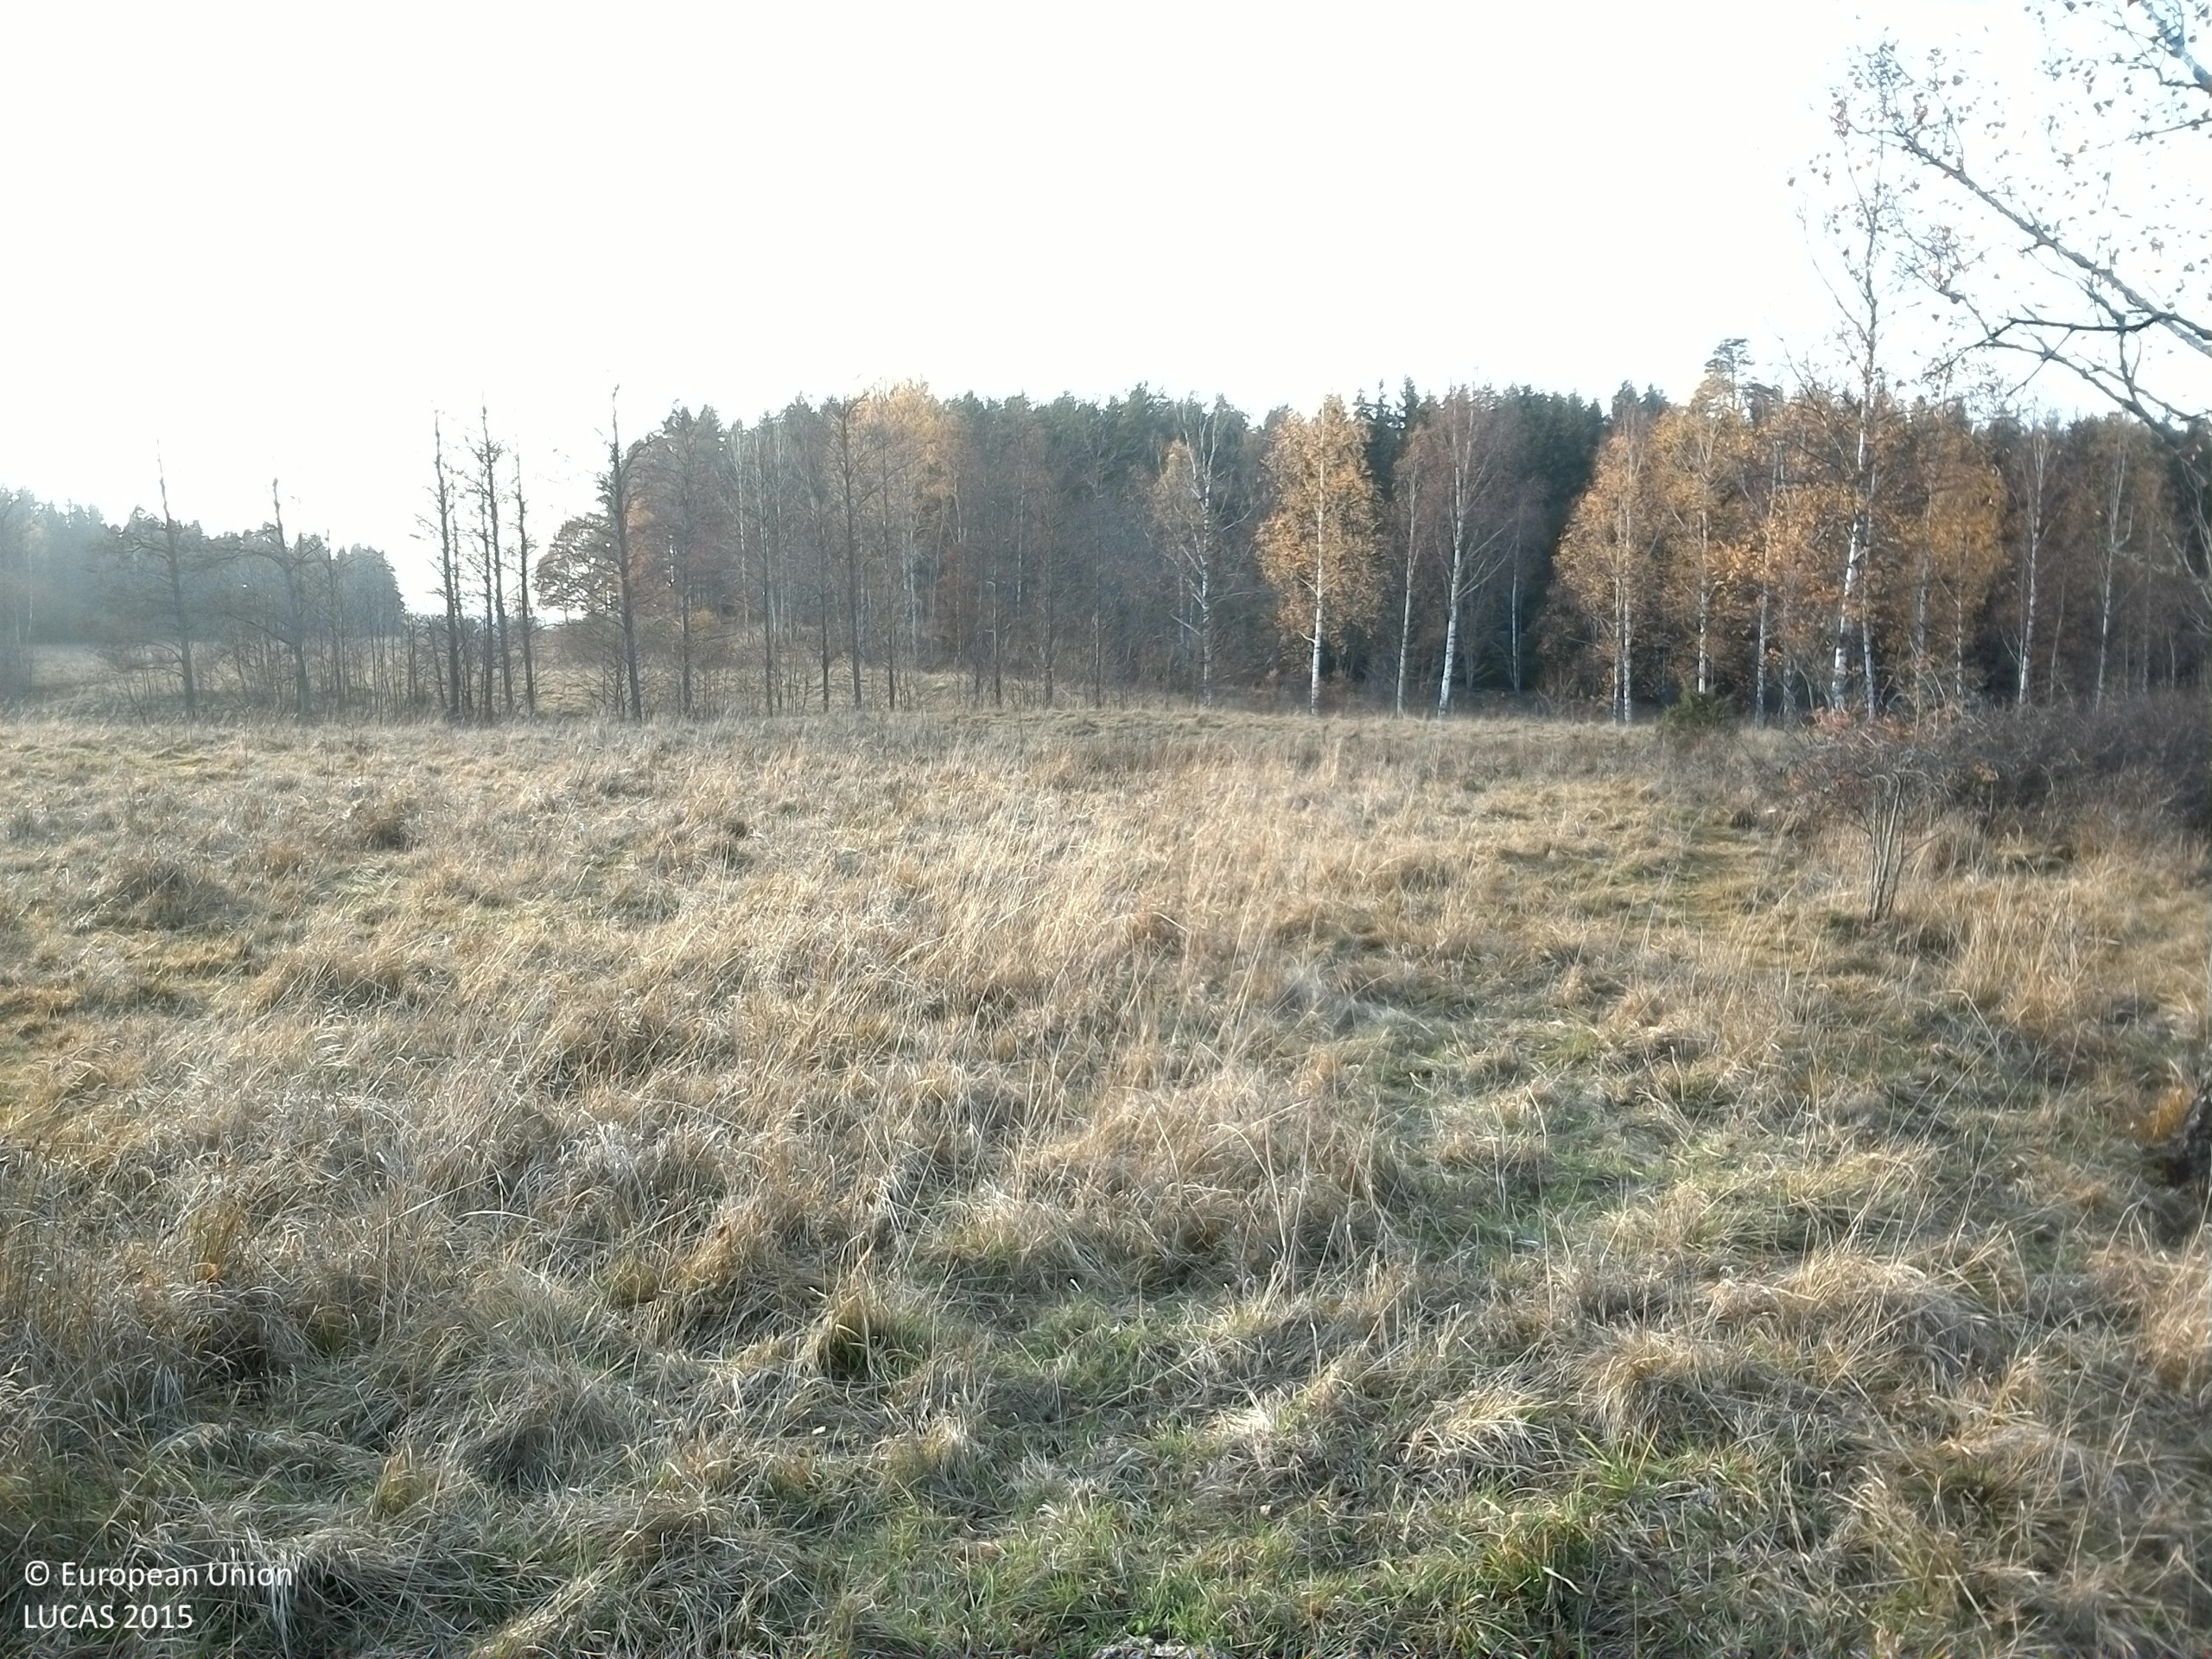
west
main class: Grassland
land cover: Grassland with sparse tree/shrub cover
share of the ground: > 75 %
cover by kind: herbaceous plants 90 %, broadleaved forest trees 5 %, shrubs 5 %
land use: Agriculture (excluding fallow land and kitchen gardens)
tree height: > 5 m
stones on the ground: < 10 %
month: October
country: SE
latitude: 59.2409
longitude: 17.1300
